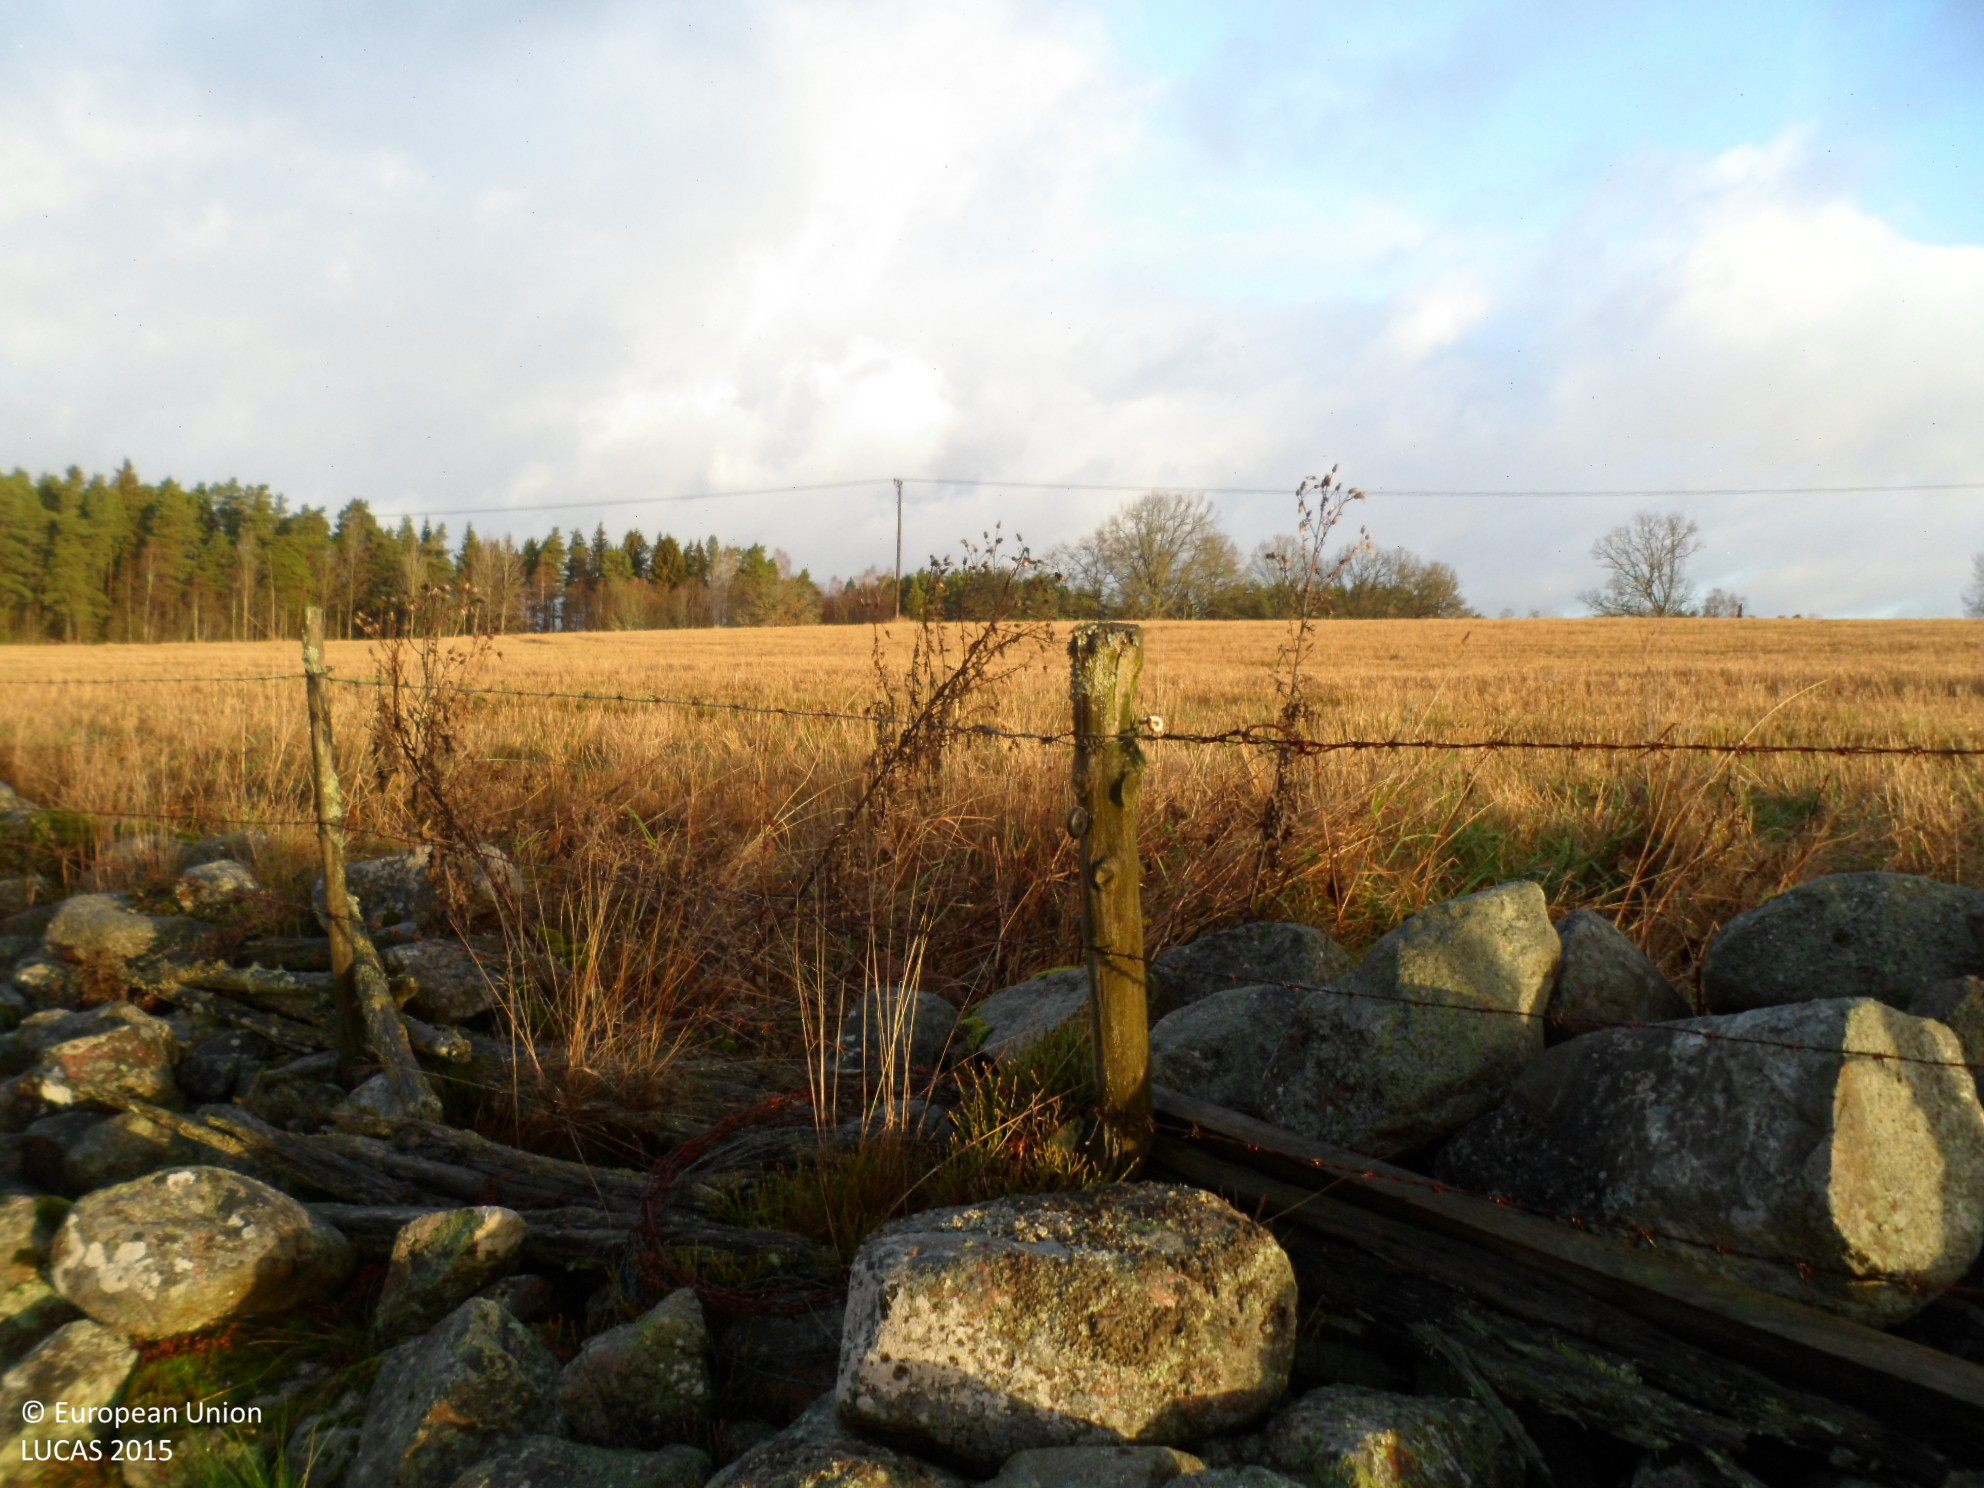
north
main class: Grassland
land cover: Grassland without tree/shrub cover
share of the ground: > 75 %
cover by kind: herbaceous plants 90 %, lichens and mosses 10 %
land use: Agriculture (excluding fallow land and kitchen gardens)
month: November
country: SE
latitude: 57.5975
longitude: 15.1662
